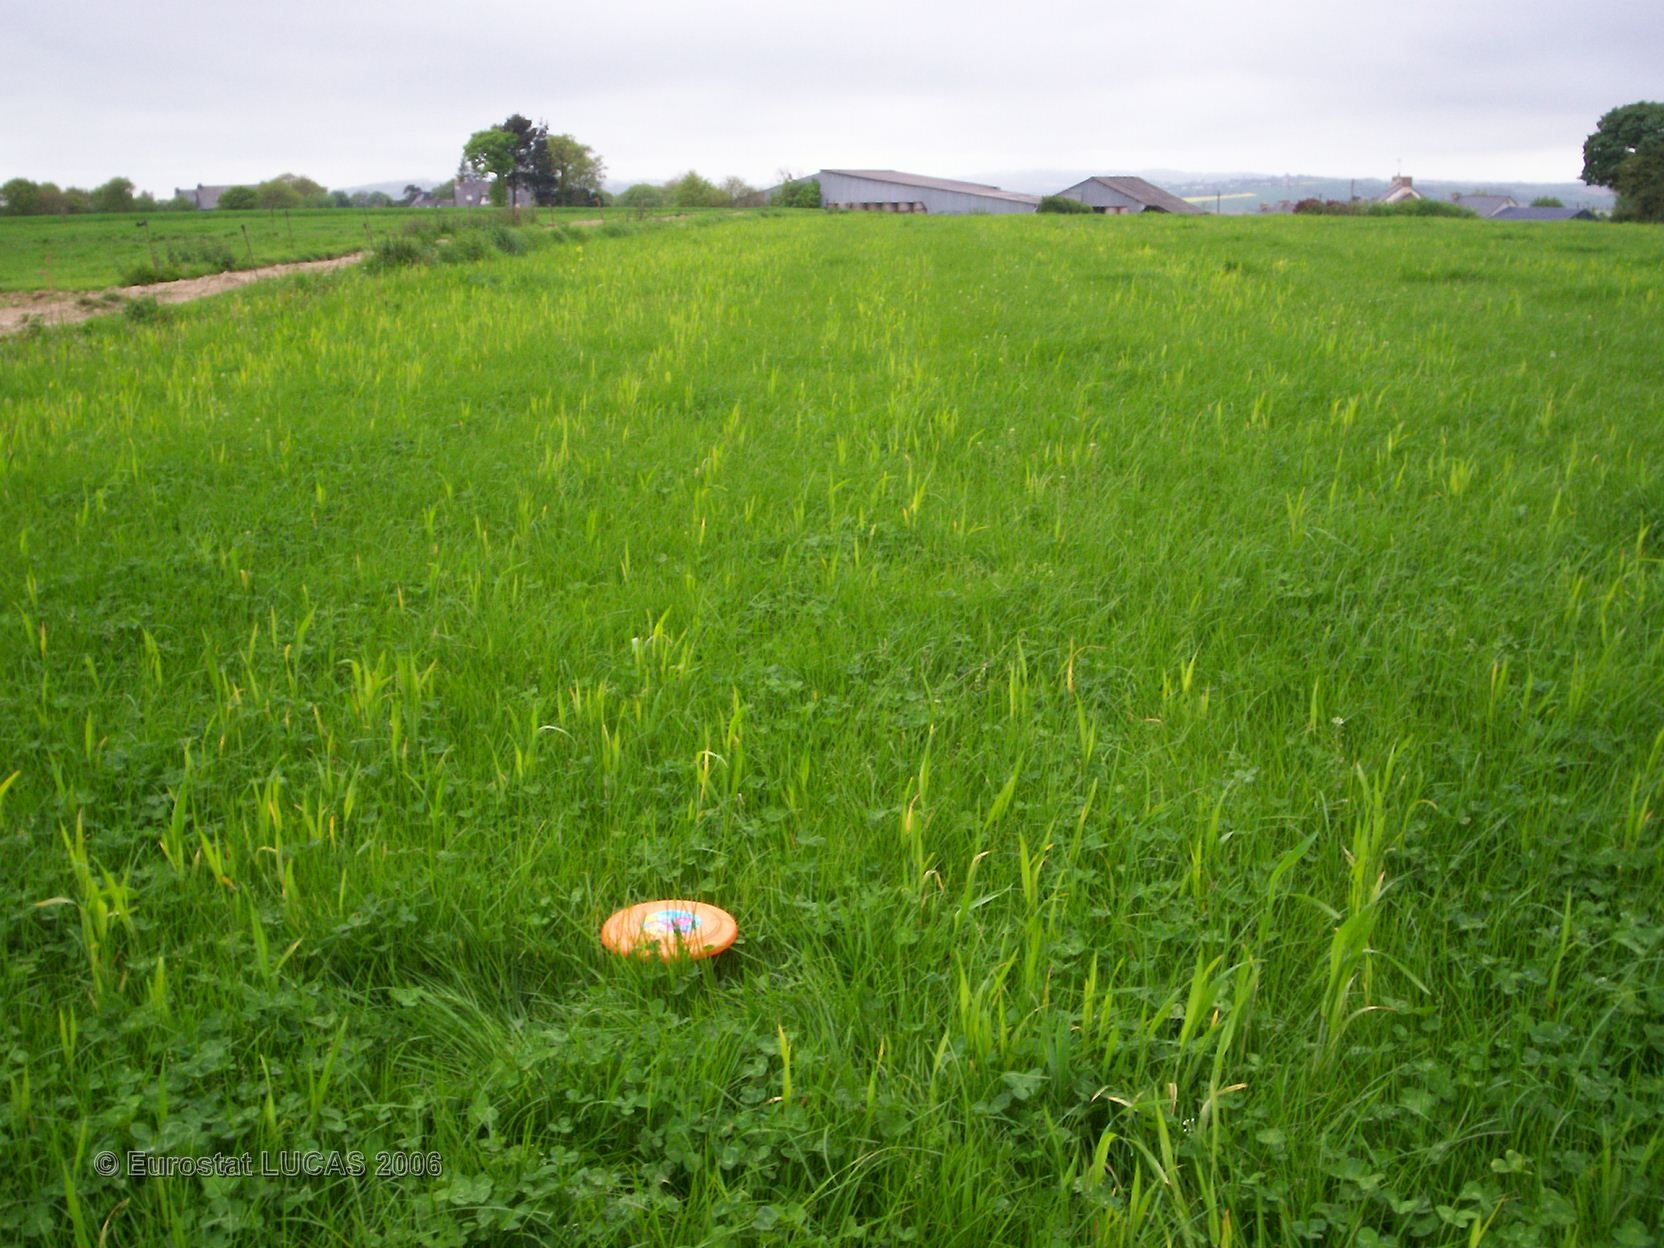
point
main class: Grassland
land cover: Grassland without tree/shrub cover
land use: Agriculture (excluding fallow land and kitchen gardens)
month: May
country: FR
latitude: 48.2899
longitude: -2.8300
